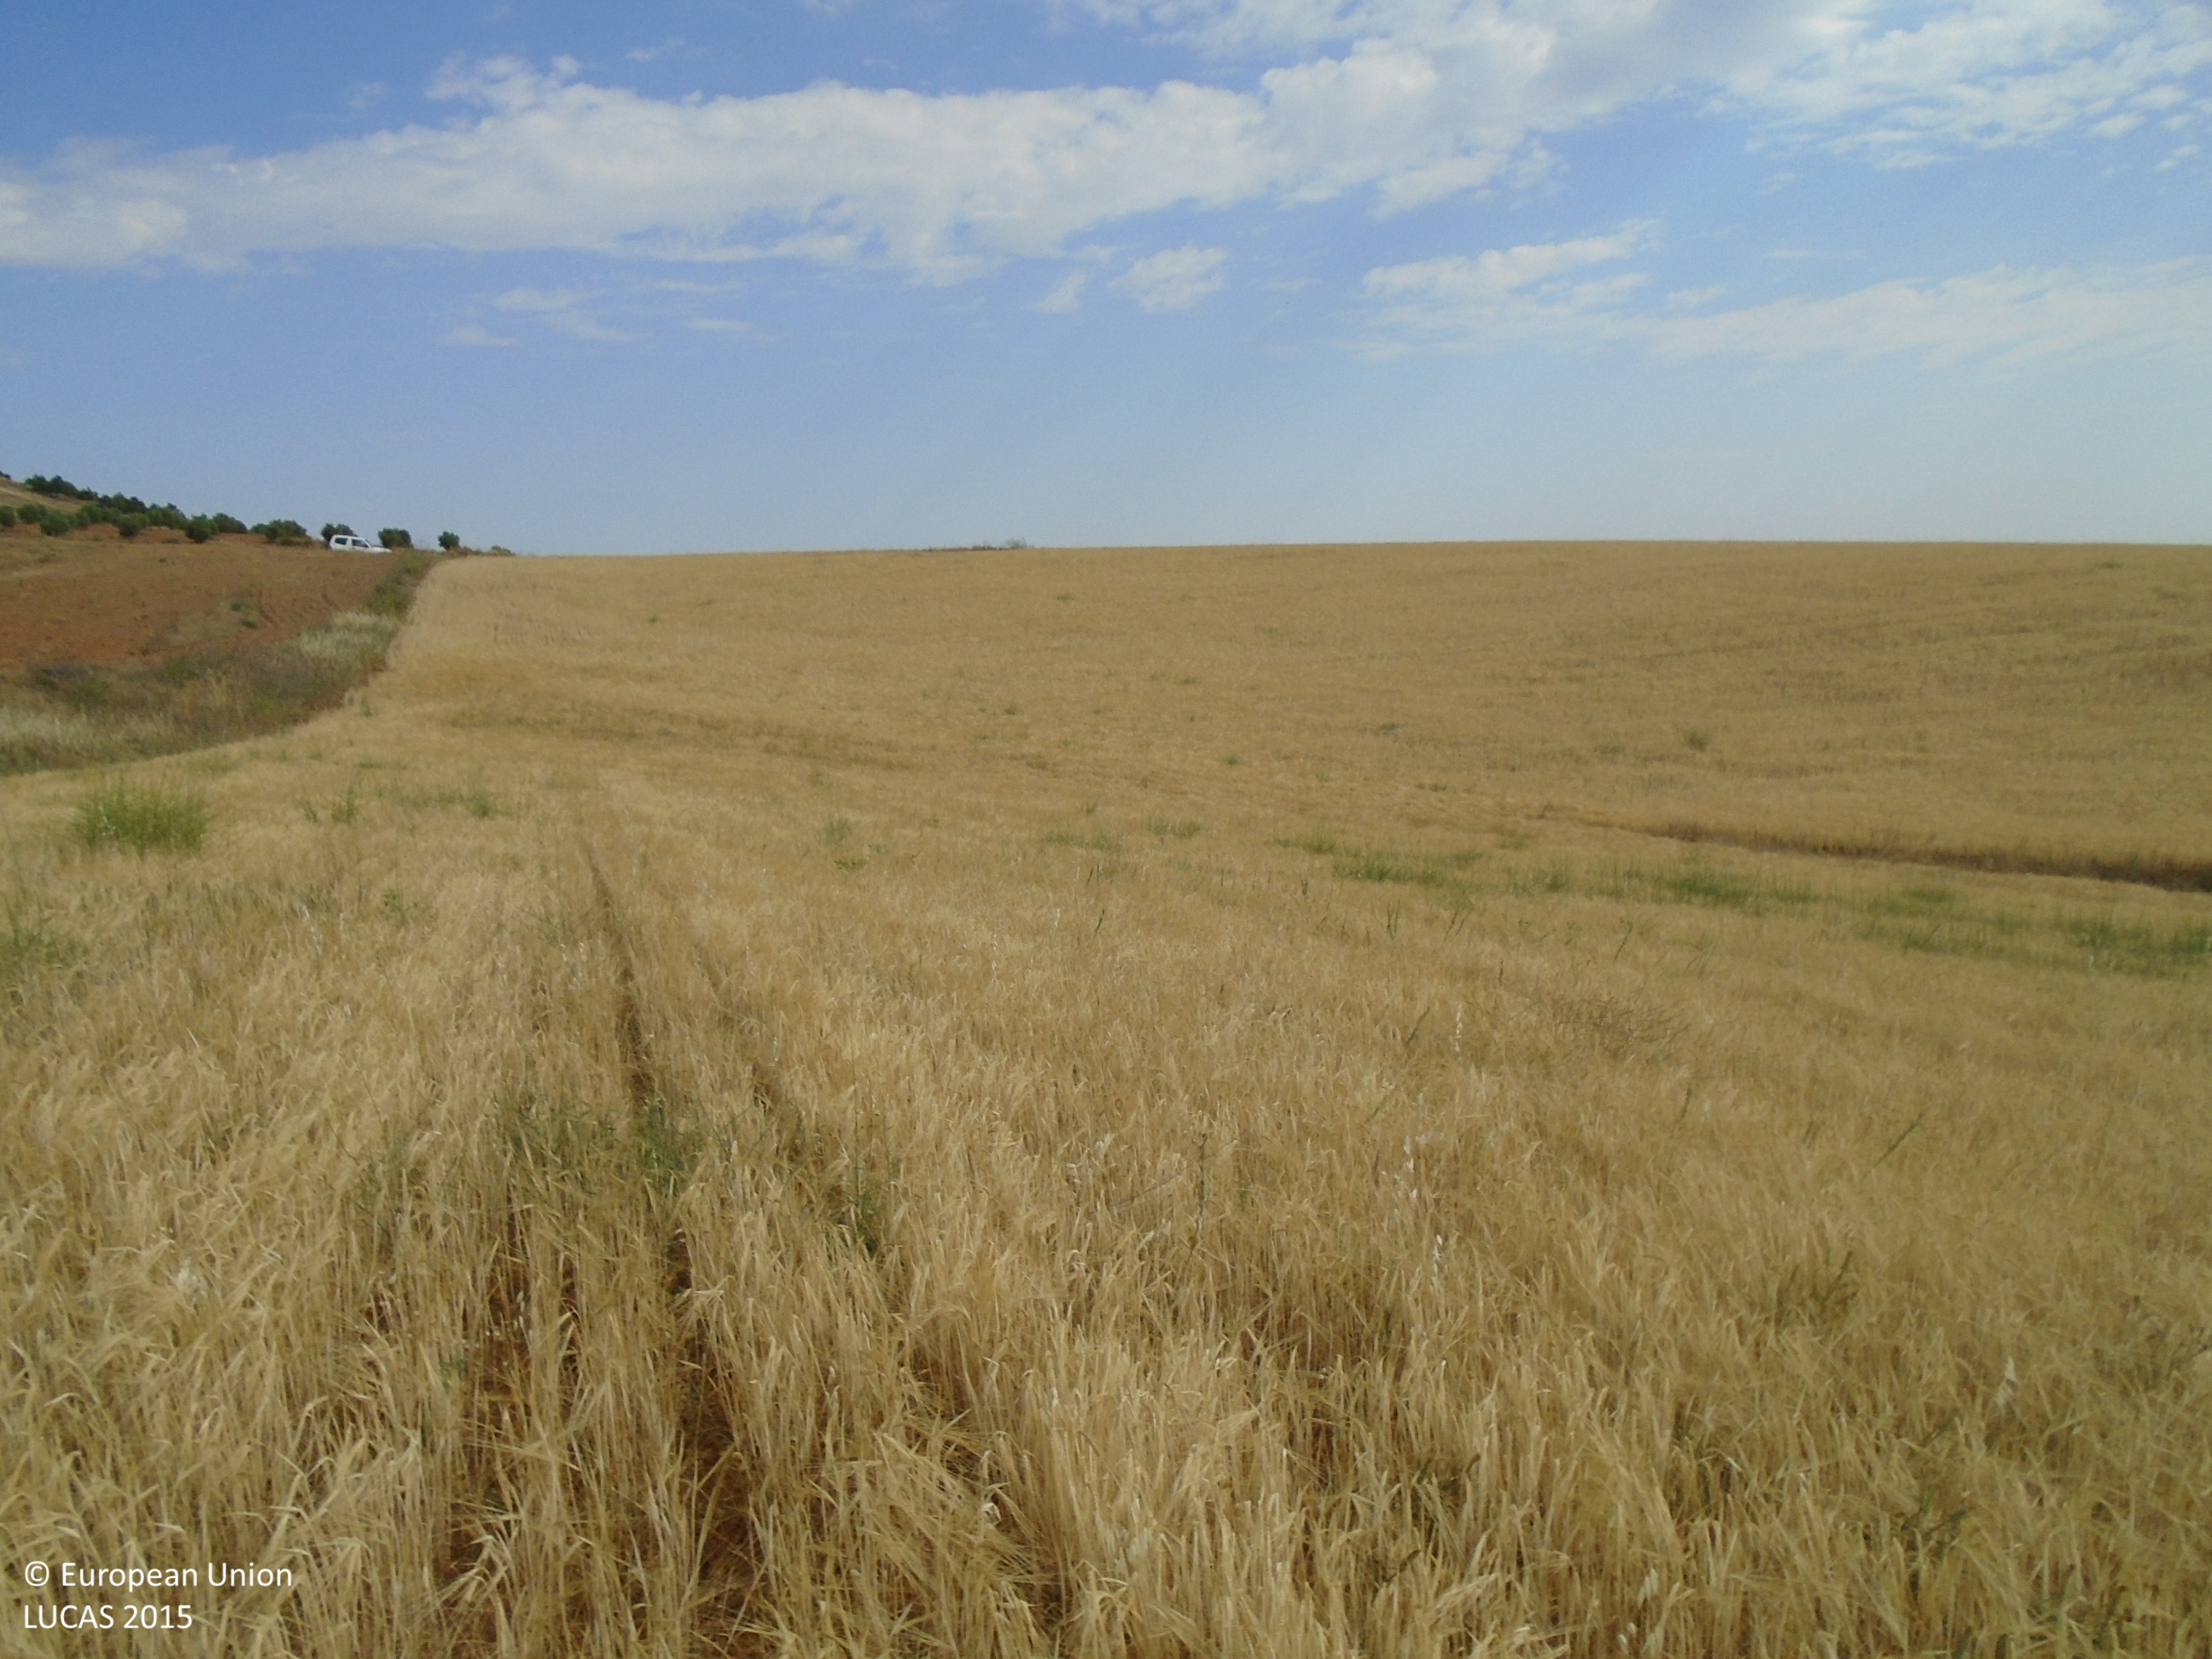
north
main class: Cropland
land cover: Barley
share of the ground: > 75 %
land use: Agriculture (excluding fallow land and kitchen gardens)
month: June
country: ES
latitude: 39.7436
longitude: -4.1904
